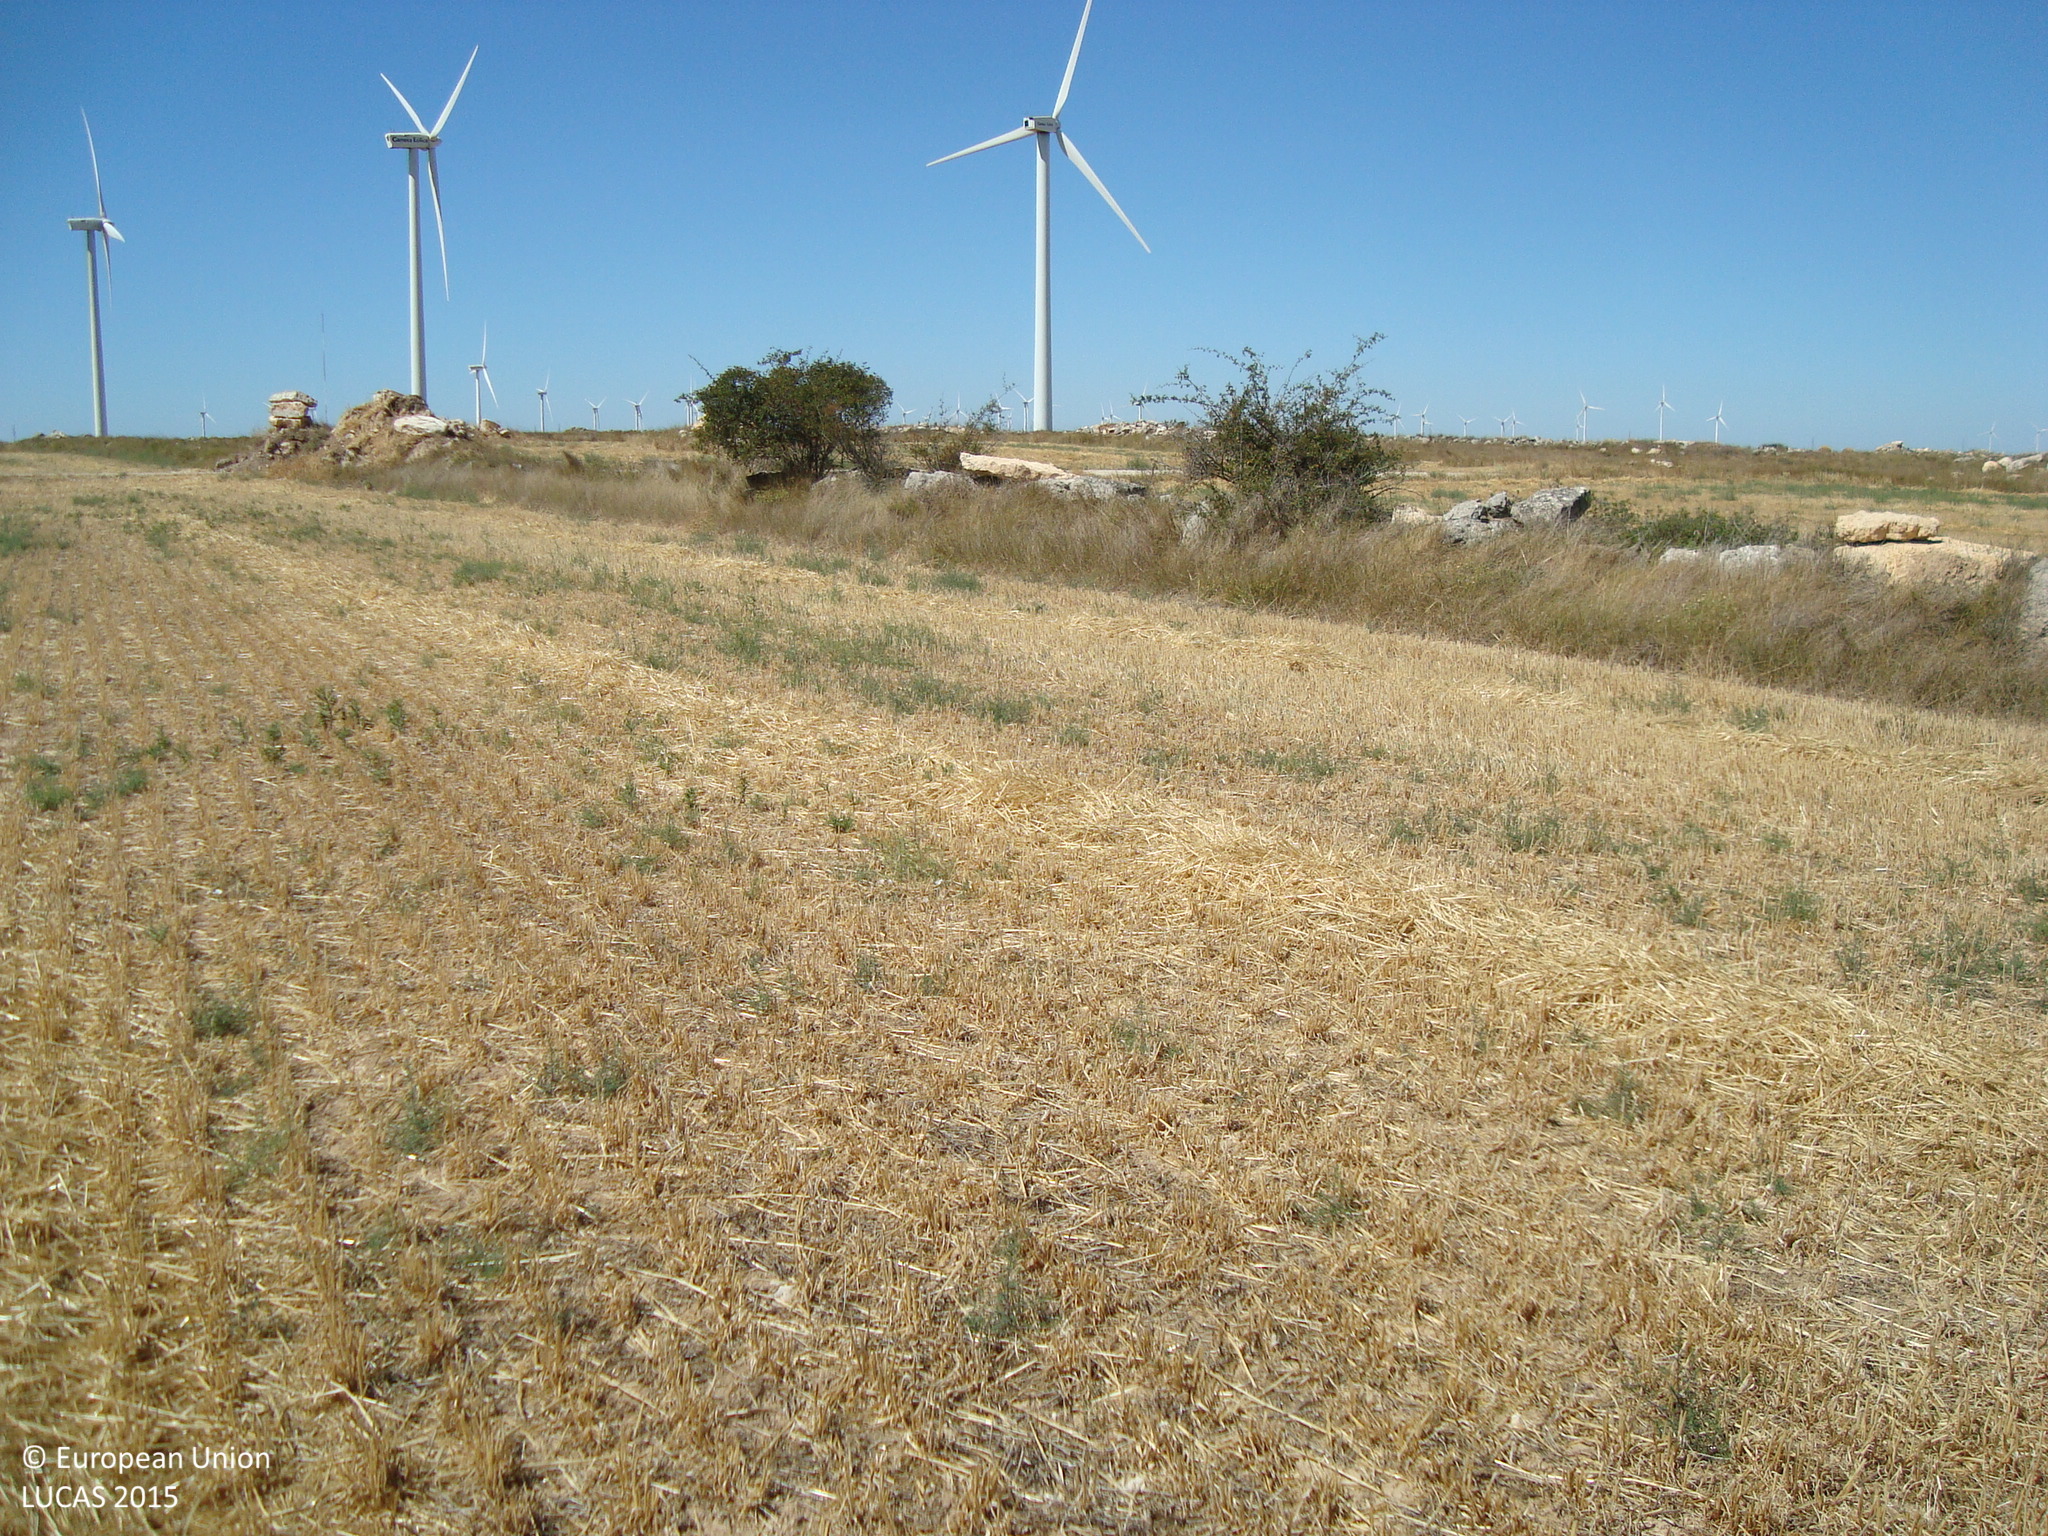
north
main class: Cropland
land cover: Barley
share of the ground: > 75 %
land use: Agriculture (excluding fallow land and kitchen gardens)
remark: Harvested field
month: August
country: ES
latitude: 42.1971
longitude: -4.1994
